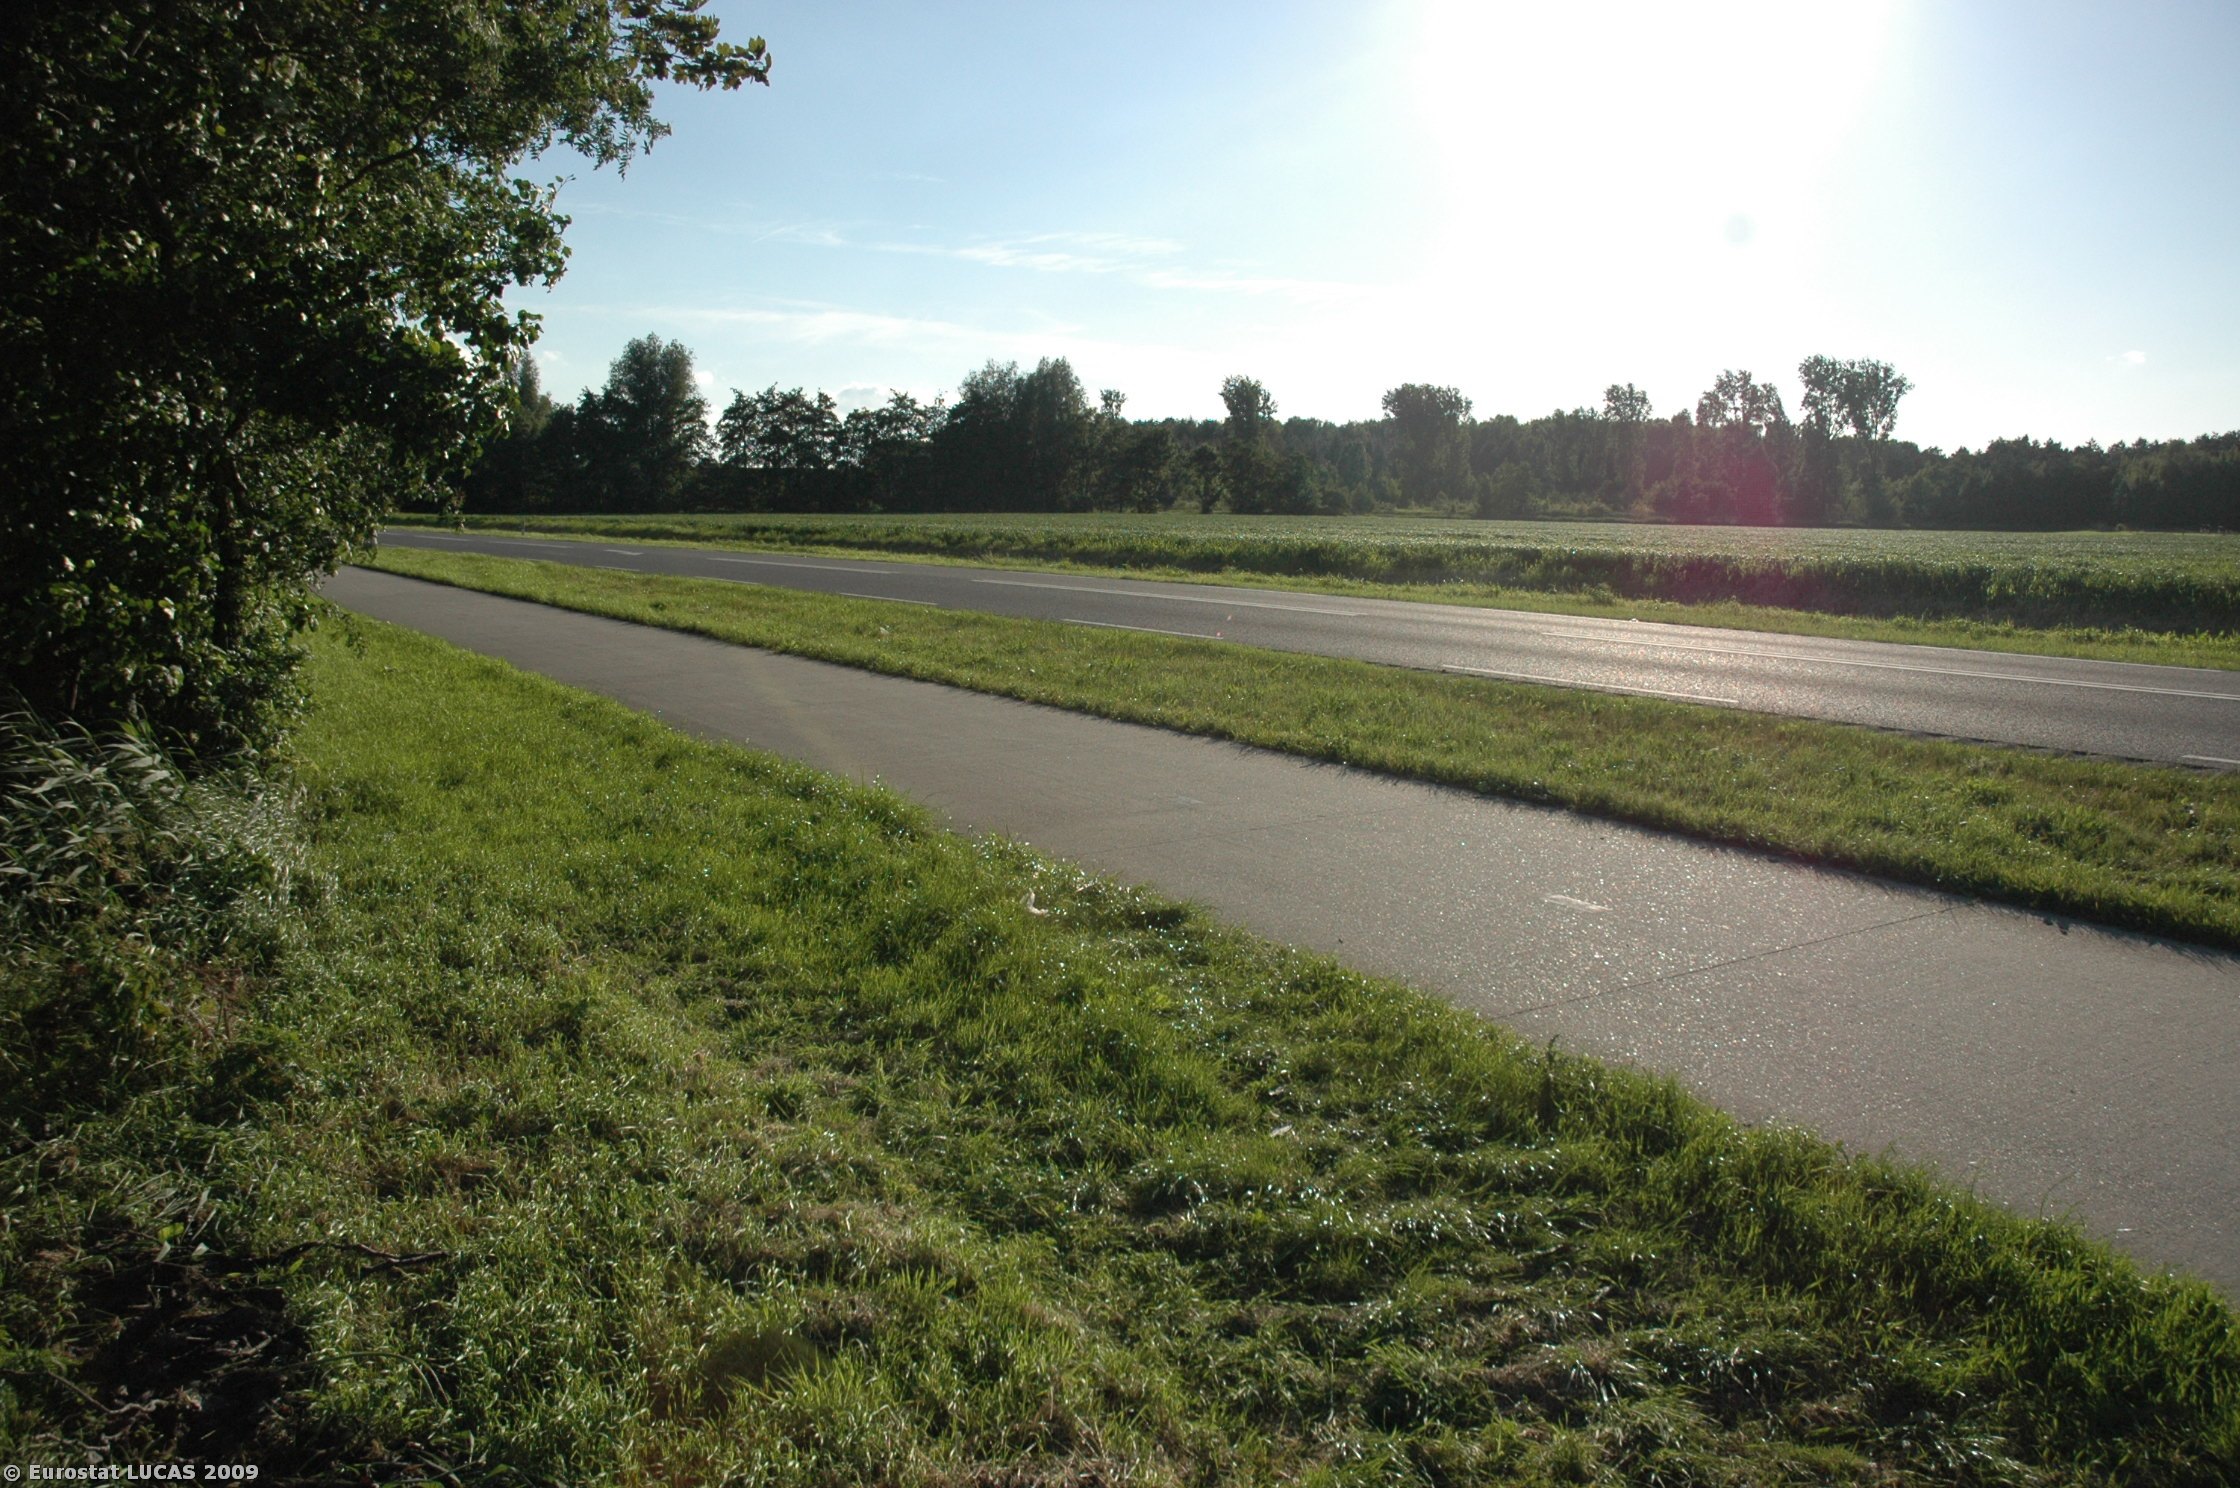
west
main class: Grassland
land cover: Grassland without tree/shrub cover
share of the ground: > 75 %
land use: Agriculture (excluding fallow land and kitchen gardens)
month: June
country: NL
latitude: 52.6753
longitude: 5.6358
